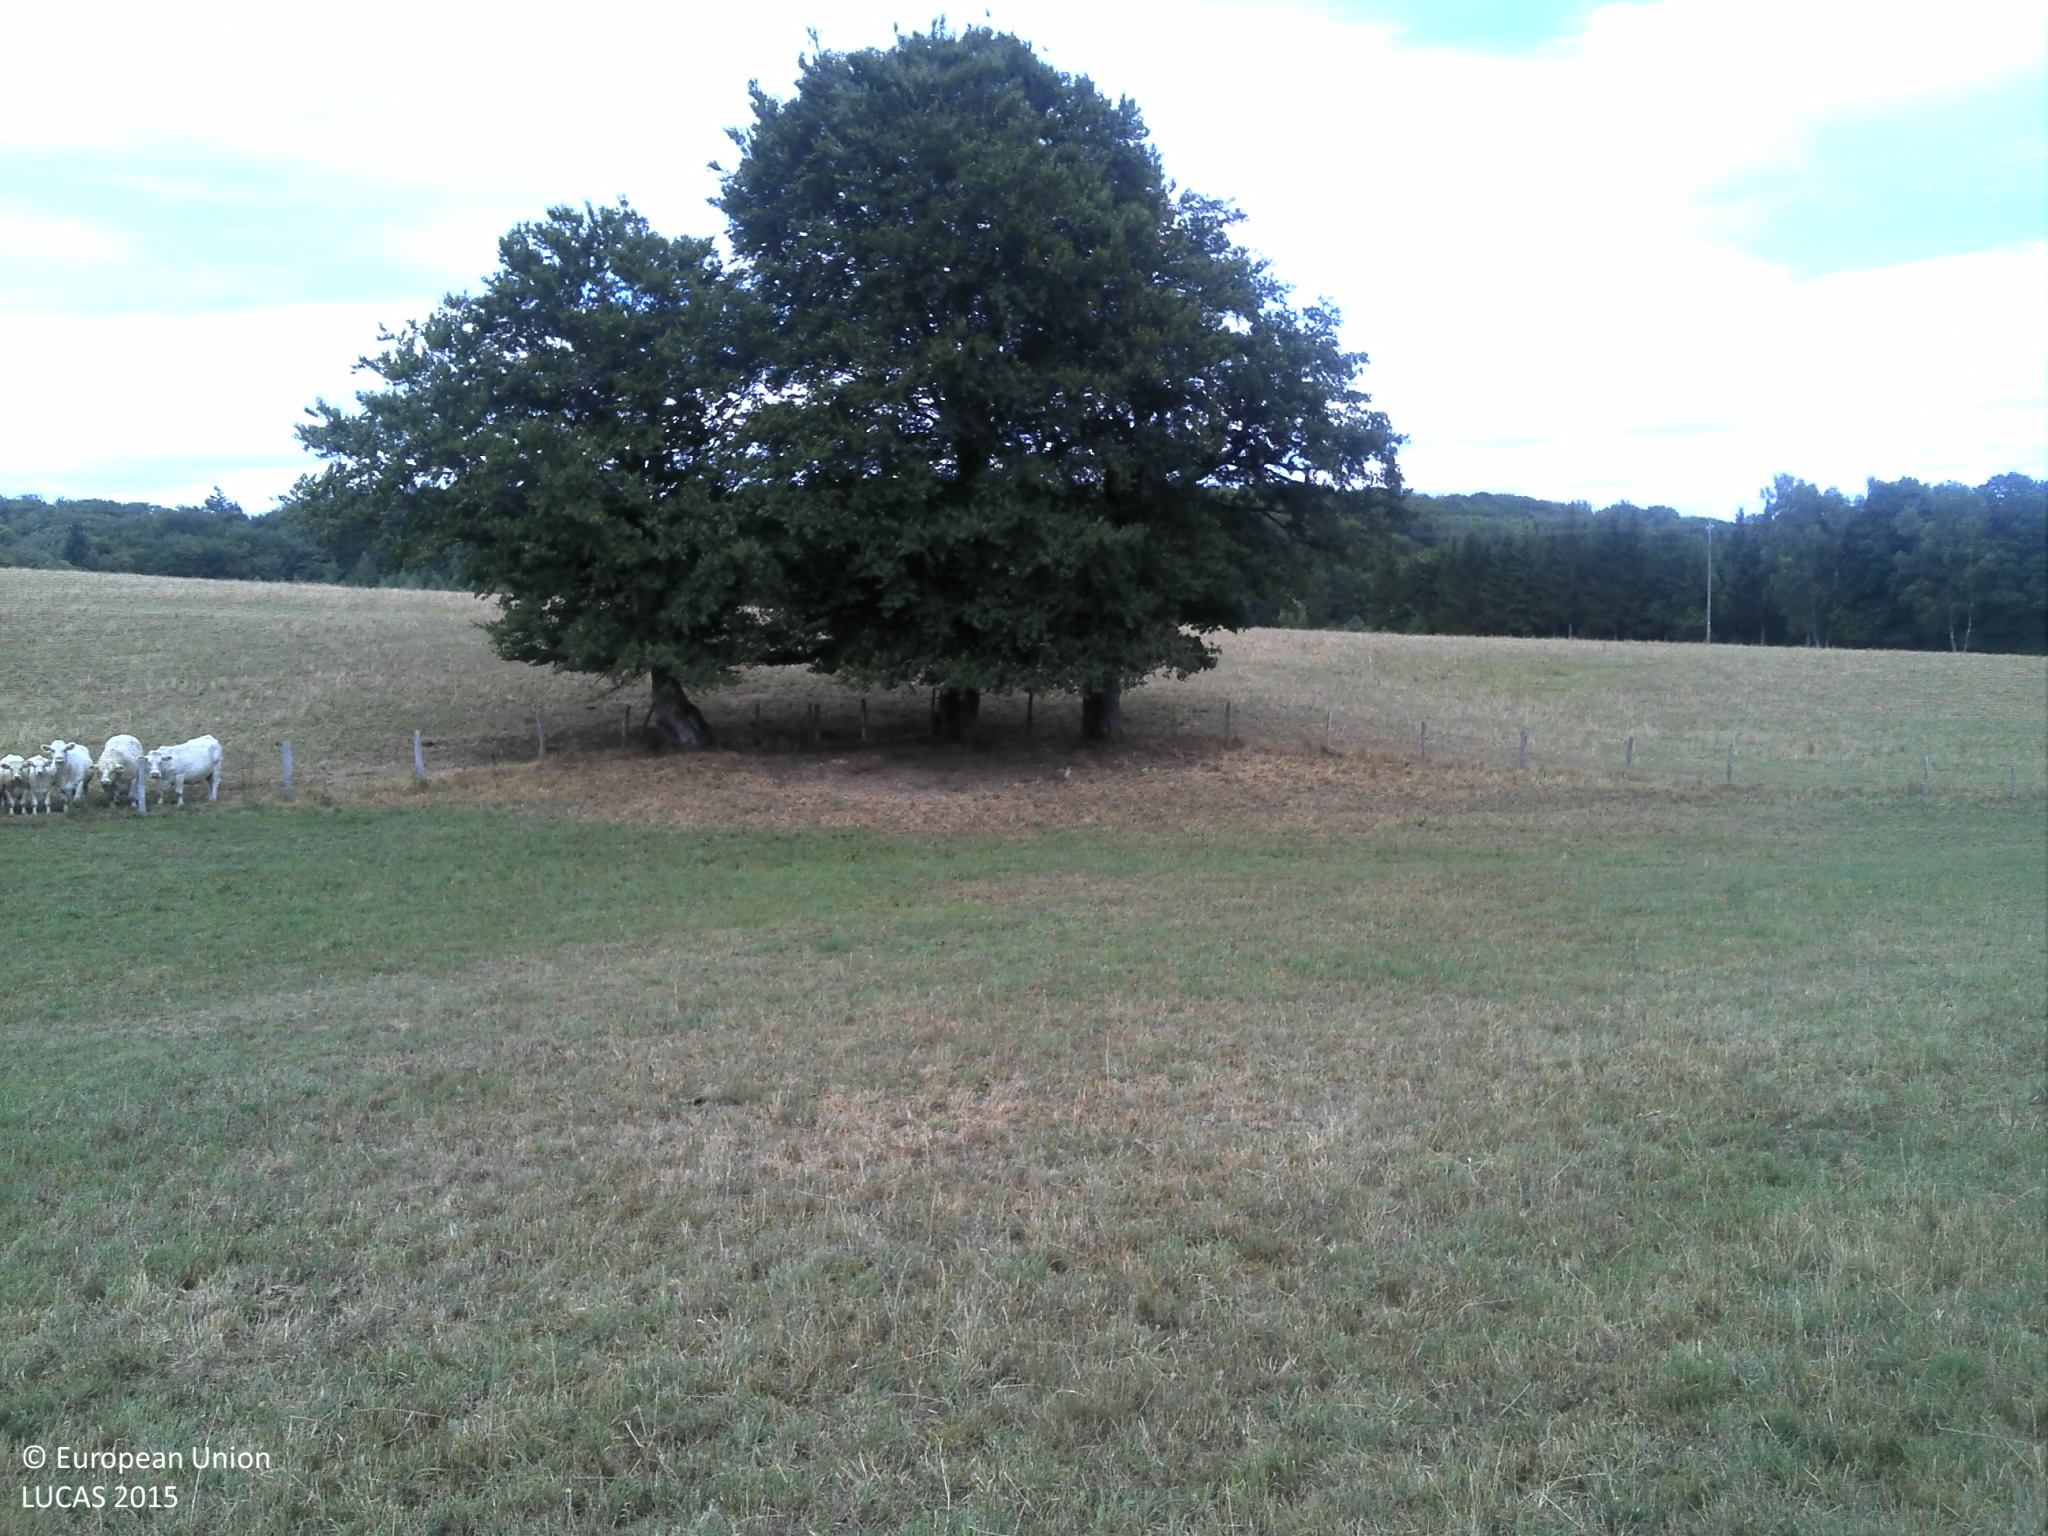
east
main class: Grassland
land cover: Grassland without tree/shrub cover
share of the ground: > 75 %
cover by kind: herbaceous plants 100 %
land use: Agriculture (excluding fallow land and kitchen gardens)
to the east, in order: Grassland without tree/shrub cover; Fences; Grassland without tree/shrub cover; Electric lines; Grassland without tree/shrub cover
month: July
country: FR
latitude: 45.6277
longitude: 2.3914
